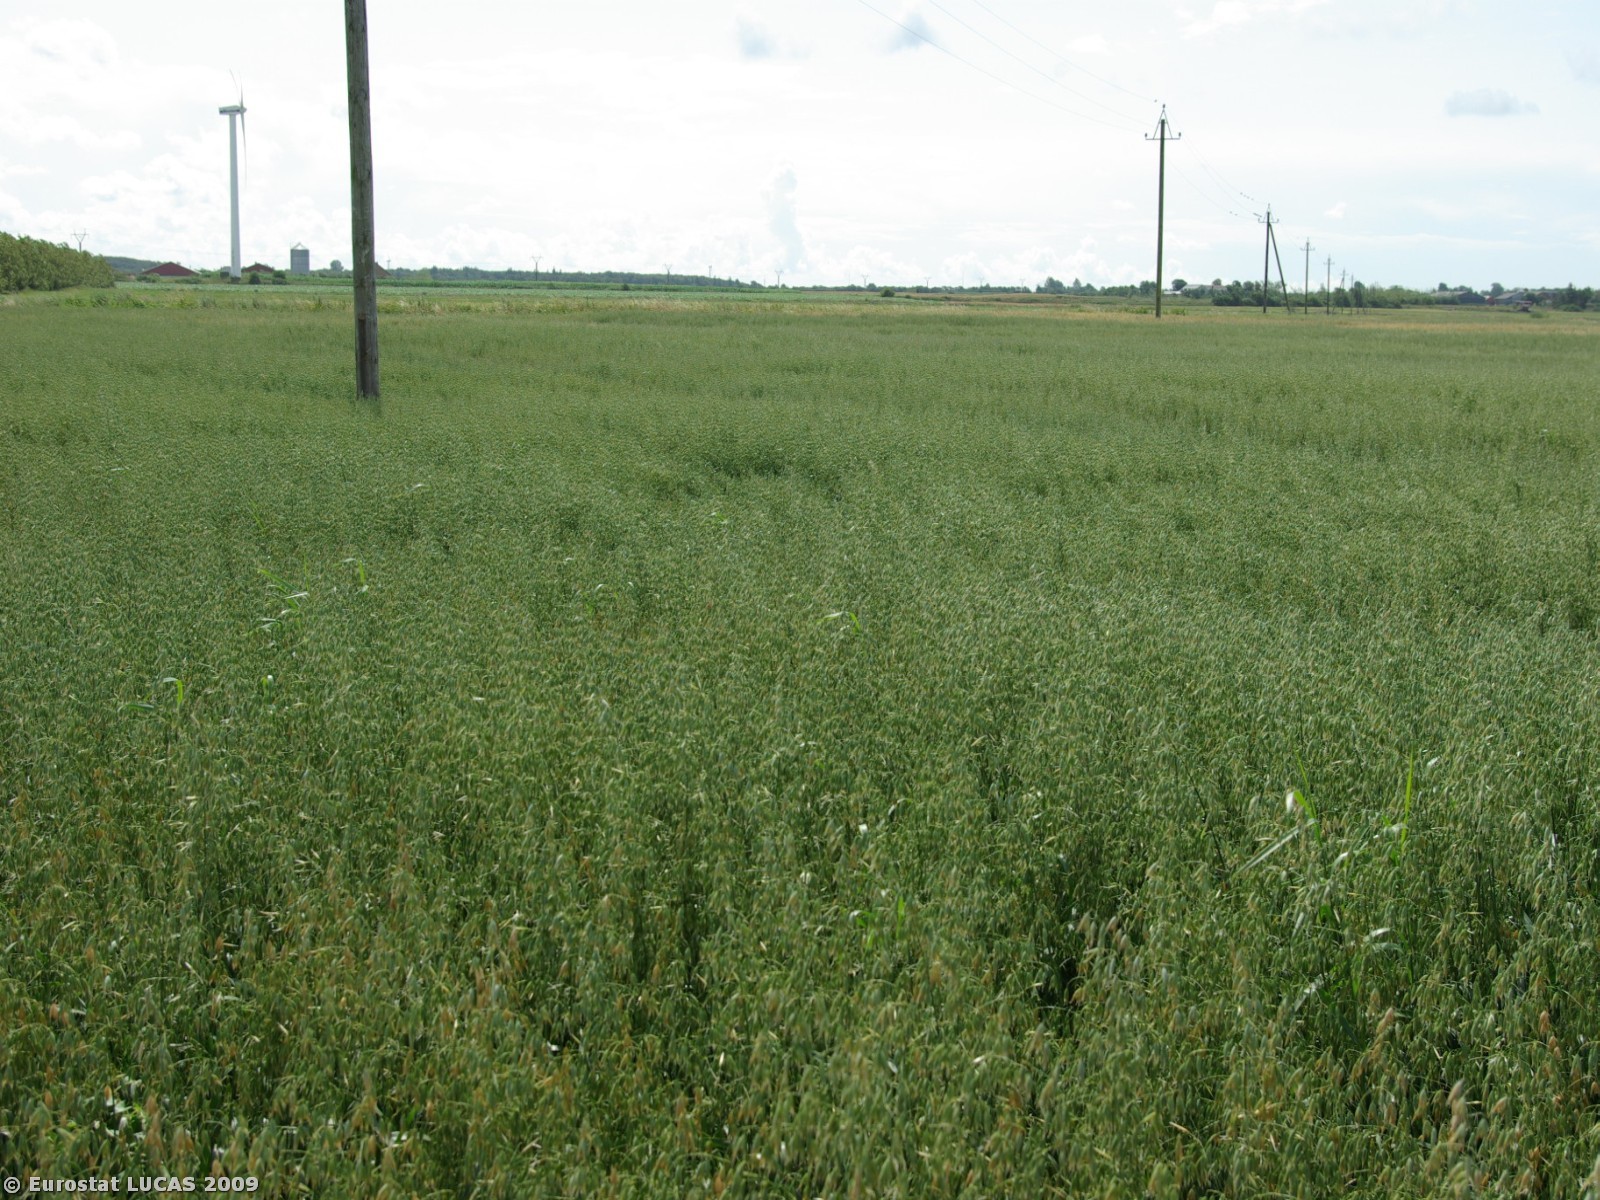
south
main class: Cropland
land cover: Oats
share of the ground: > 75 %
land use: Agriculture (excluding fallow land and kitchen gardens)
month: July
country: DK
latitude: 55.0316
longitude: 8.7962
